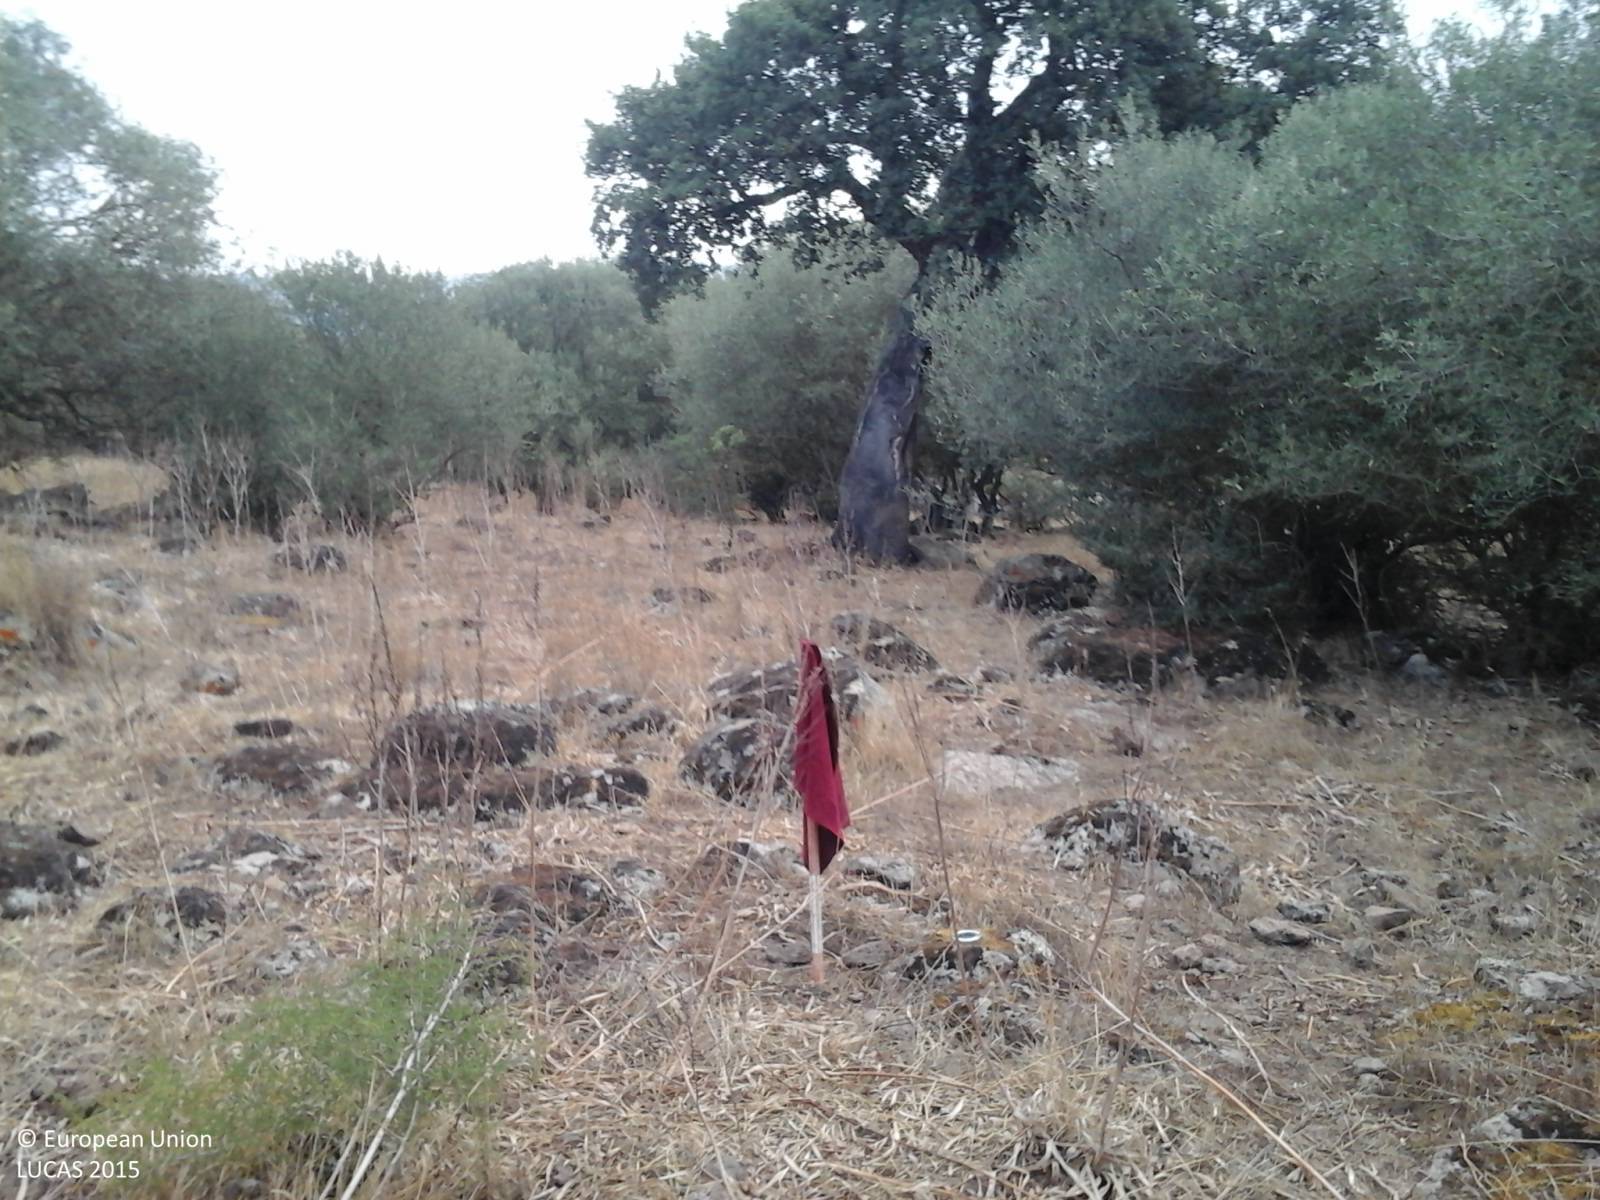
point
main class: Cropland
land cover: Olive groves
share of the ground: 10 - 25 %
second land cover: Spontaneously vegetated surfaces
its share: > 75 %
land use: Agriculture (excluding fallow land and kitchen gardens)
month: July
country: IT
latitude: 40.6405
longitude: 8.8351
